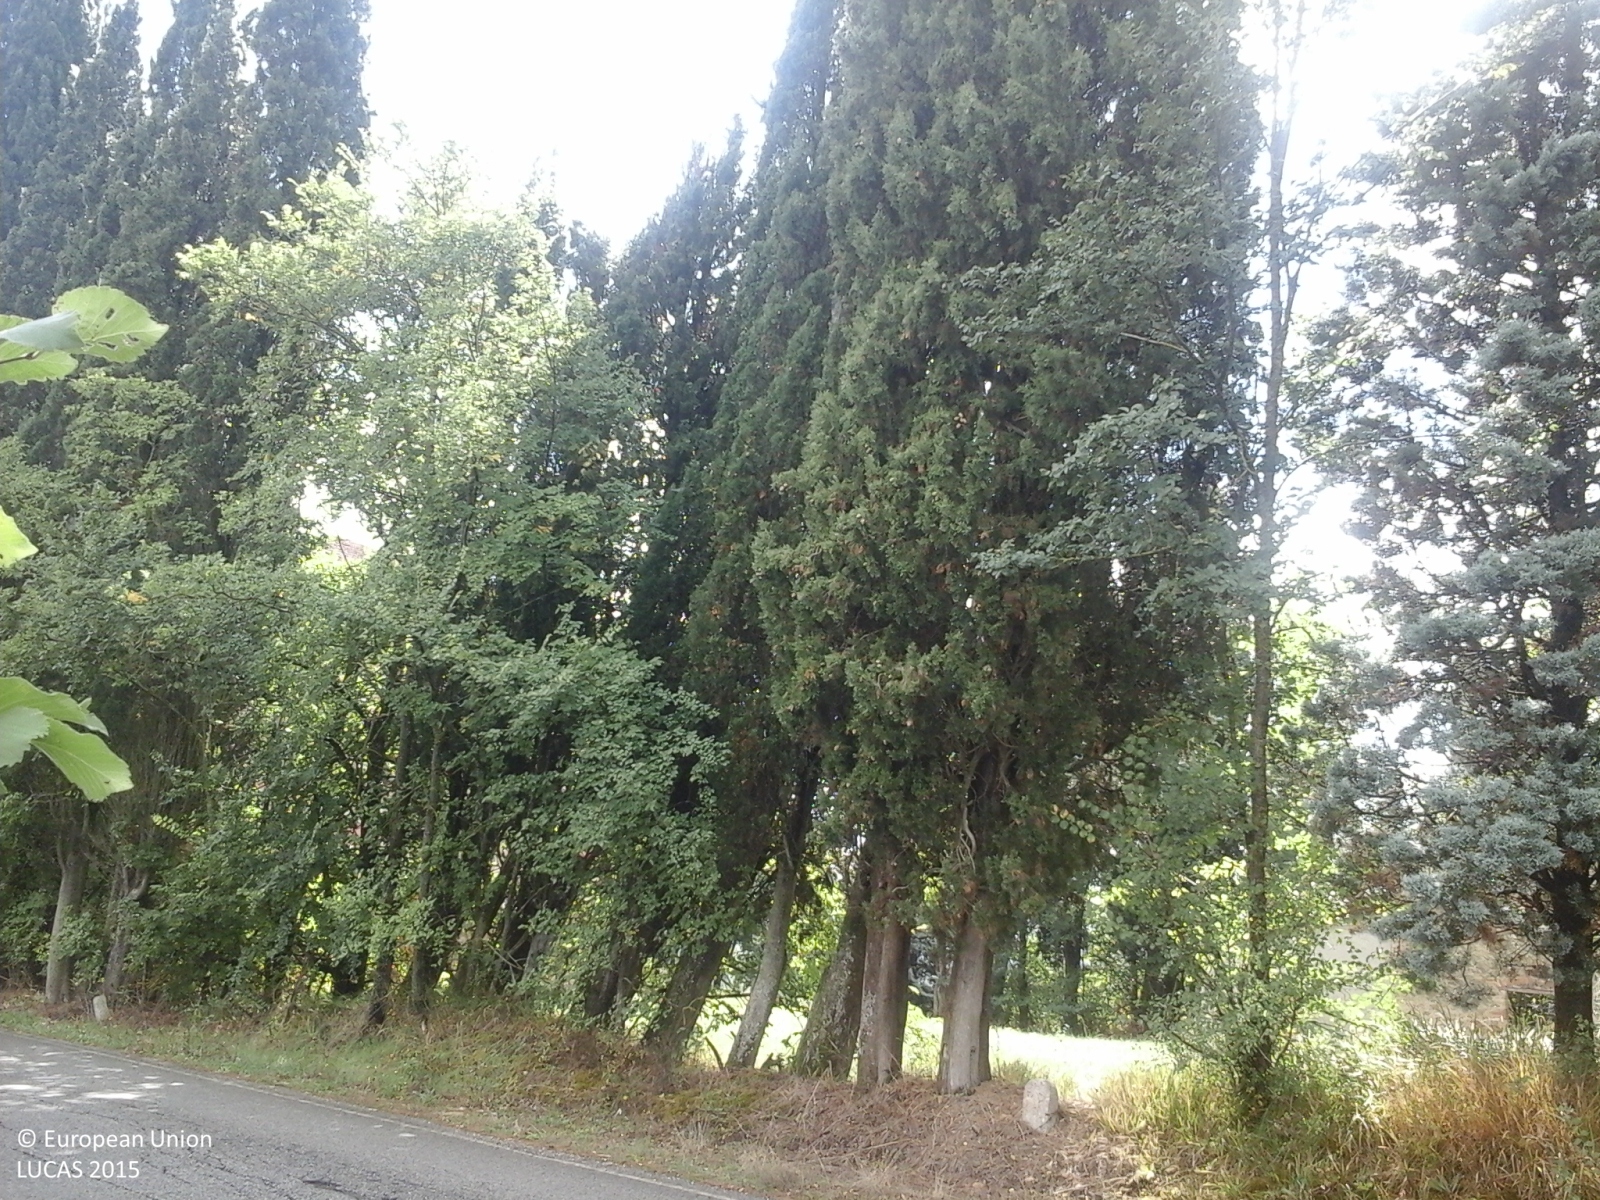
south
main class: Woodland
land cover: Broadleaved woodland
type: thermophilous deciduous forest
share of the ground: > 75 %
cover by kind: broadleaved forest trees 95 %, shrubs 5 %
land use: Forestry
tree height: > 5 m
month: October
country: IT
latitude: 43.4984
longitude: 12.1338
